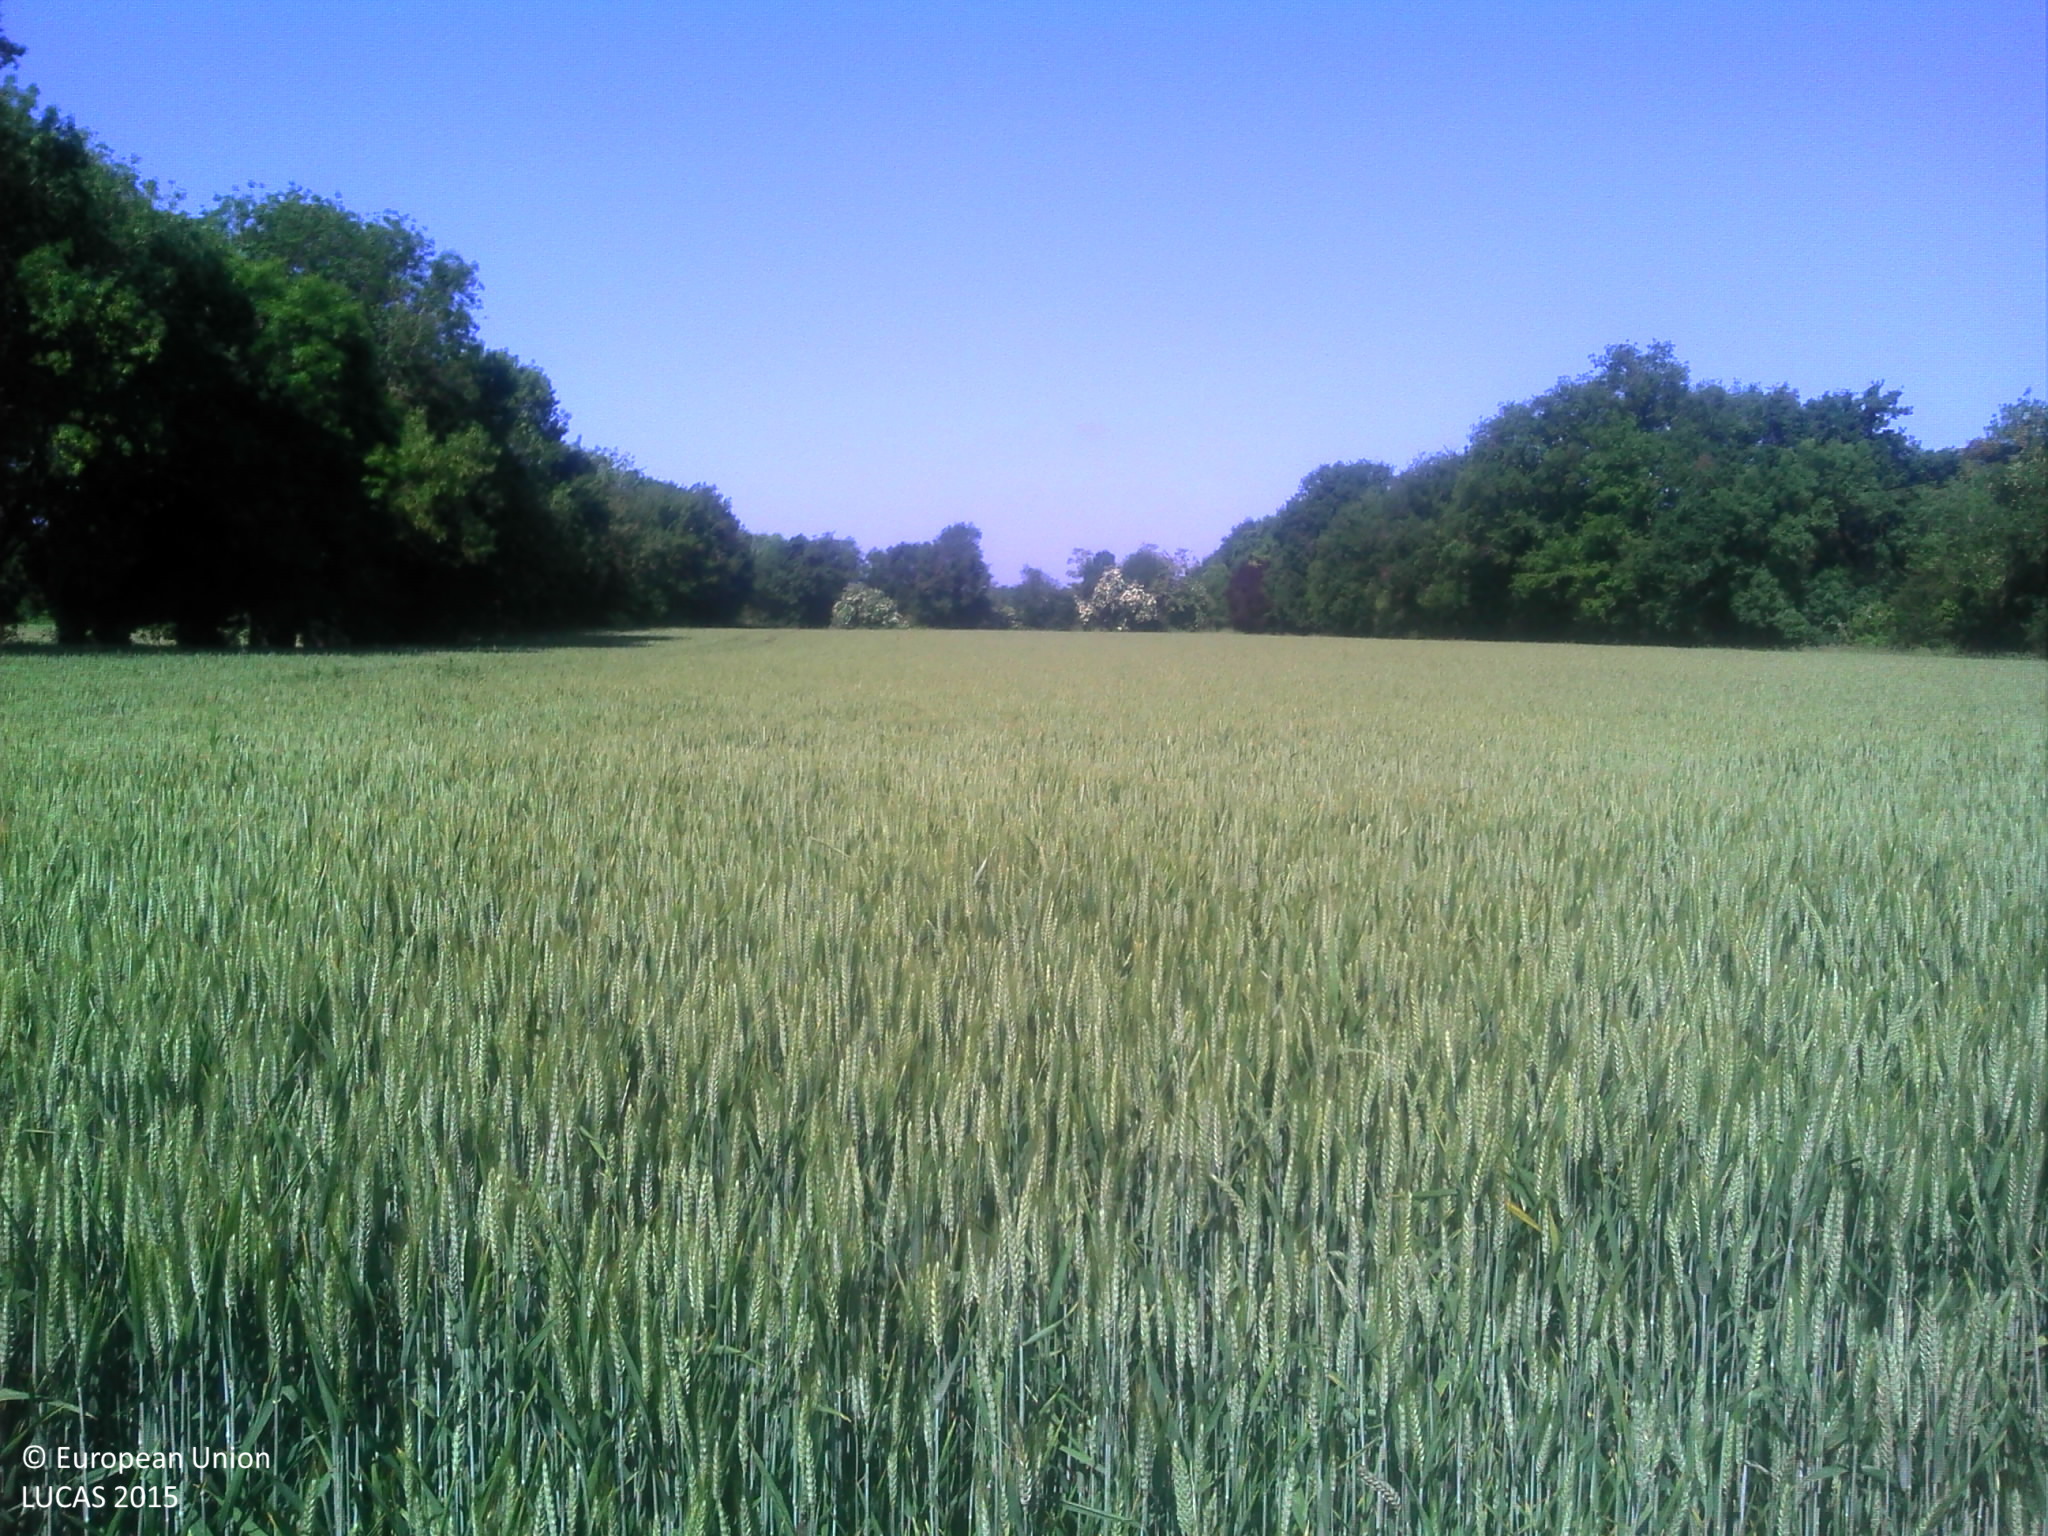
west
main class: Cropland
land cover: Common wheat
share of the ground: > 75 %
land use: Agriculture (excluding fallow land and kitchen gardens)
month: May
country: FR
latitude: 47.3790
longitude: -1.0163
